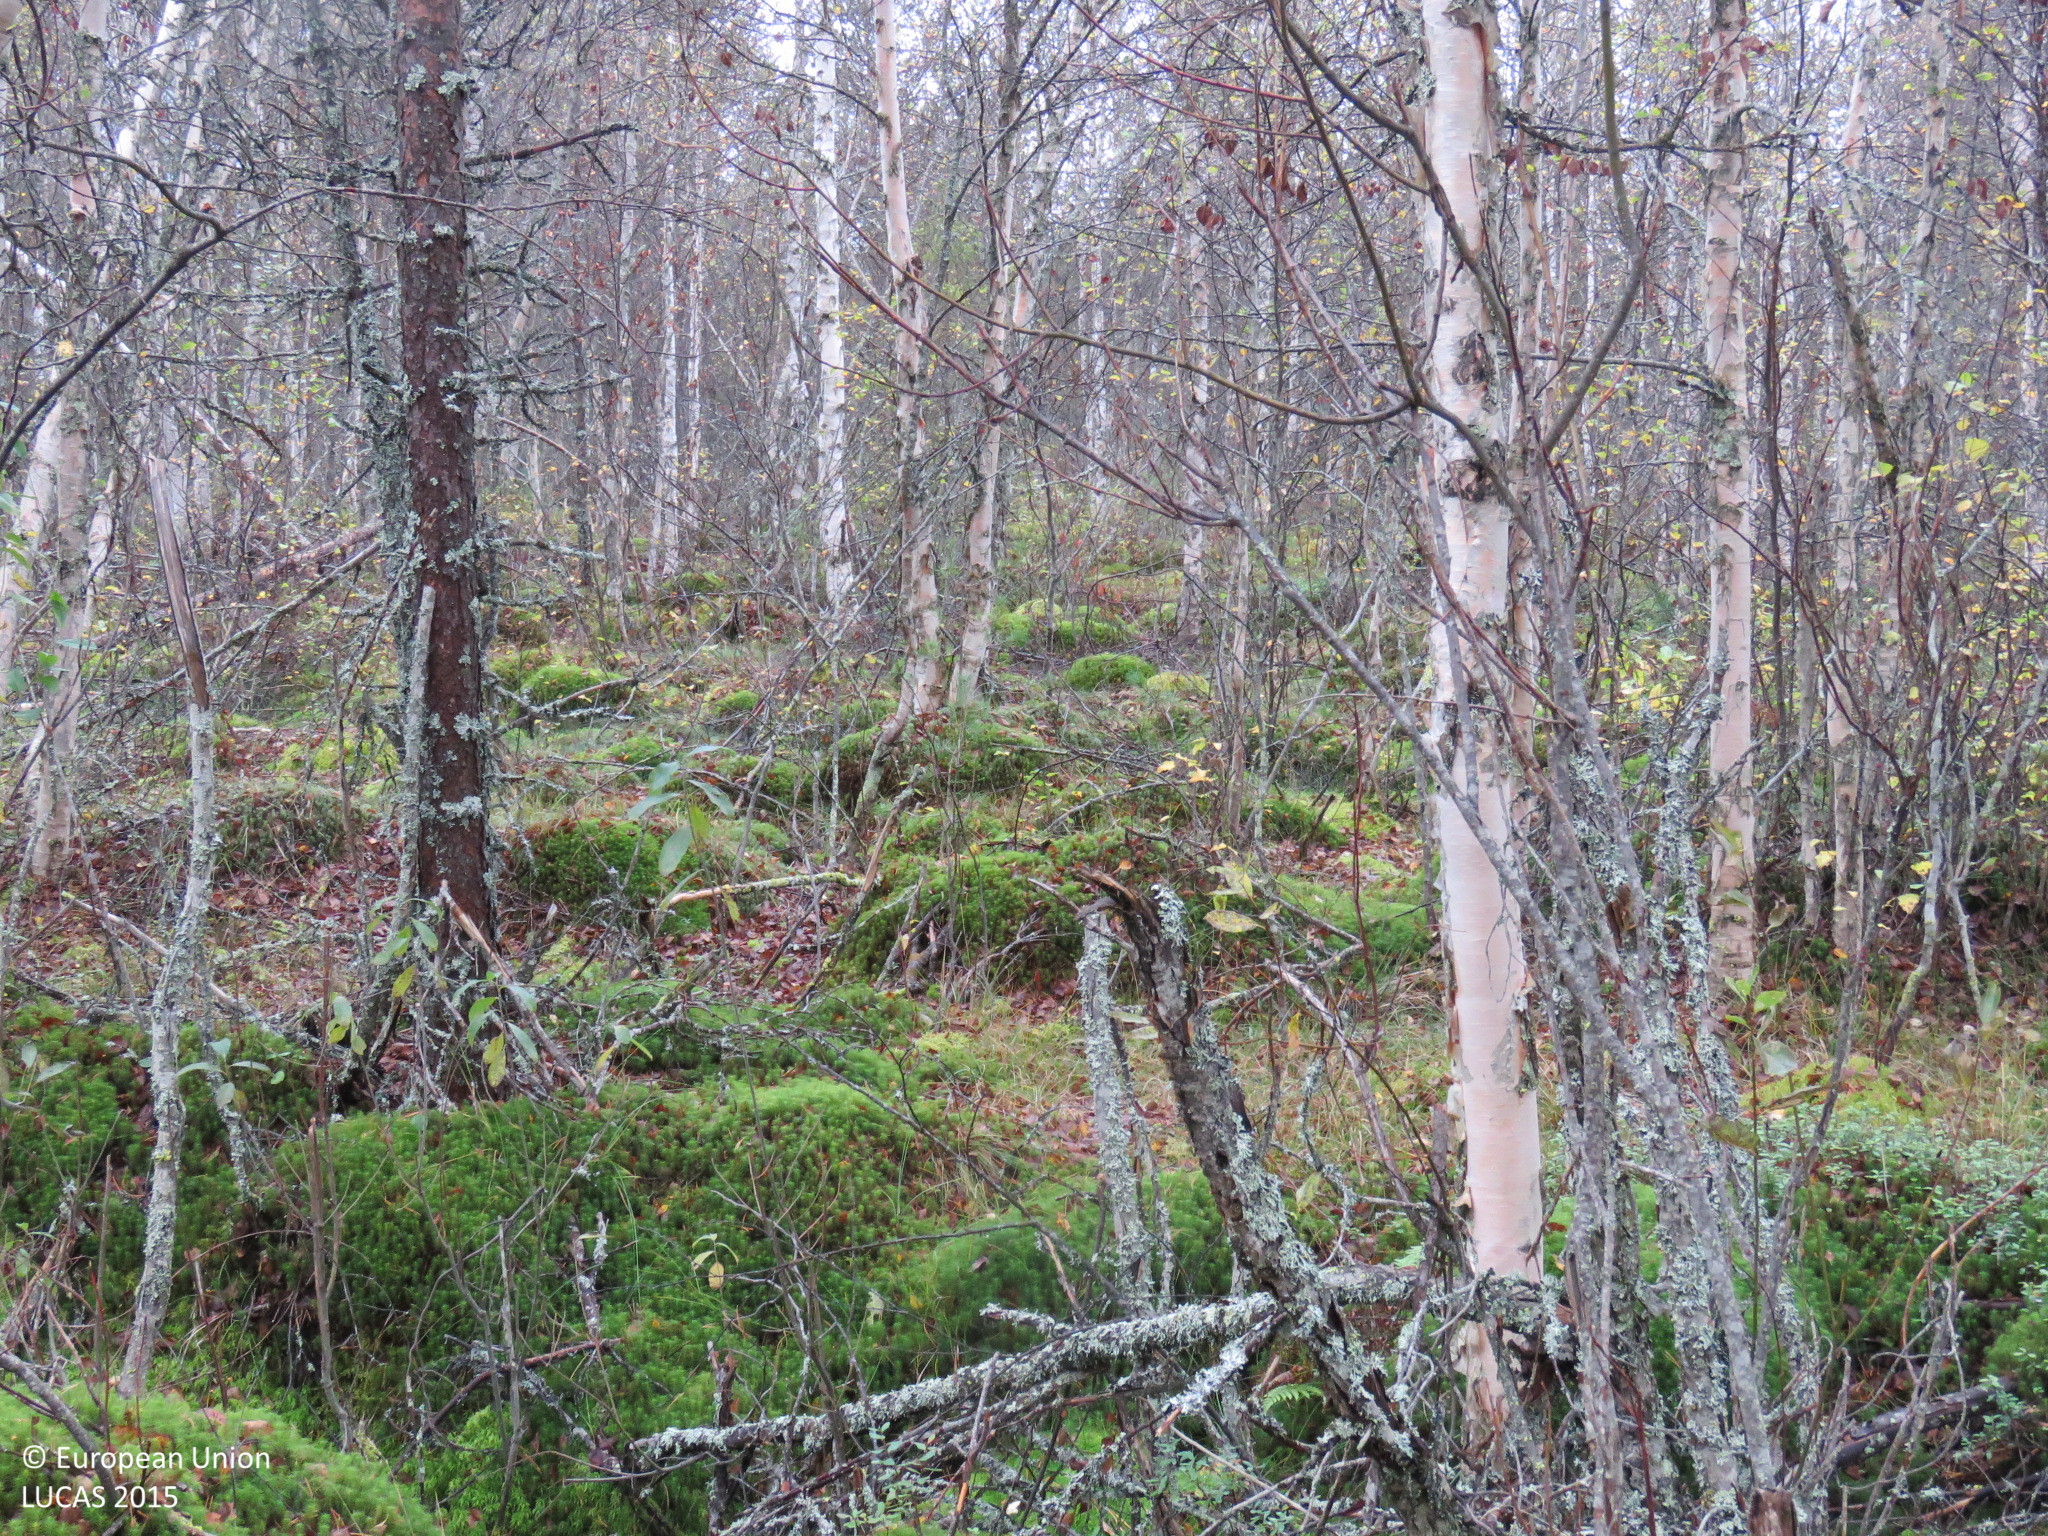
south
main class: Woodland
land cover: Broadleaved woodland
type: mire and swamp forests
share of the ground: > 75 %
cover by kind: broadleaved forest trees 70 %, coniferous forest trees 10 %, herbaceous plants 10 %, lichens and mosses 10 %
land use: Forestry
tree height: > 5 m
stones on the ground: < 10 %
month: September
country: FI
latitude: 65.1924
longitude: 26.8837
